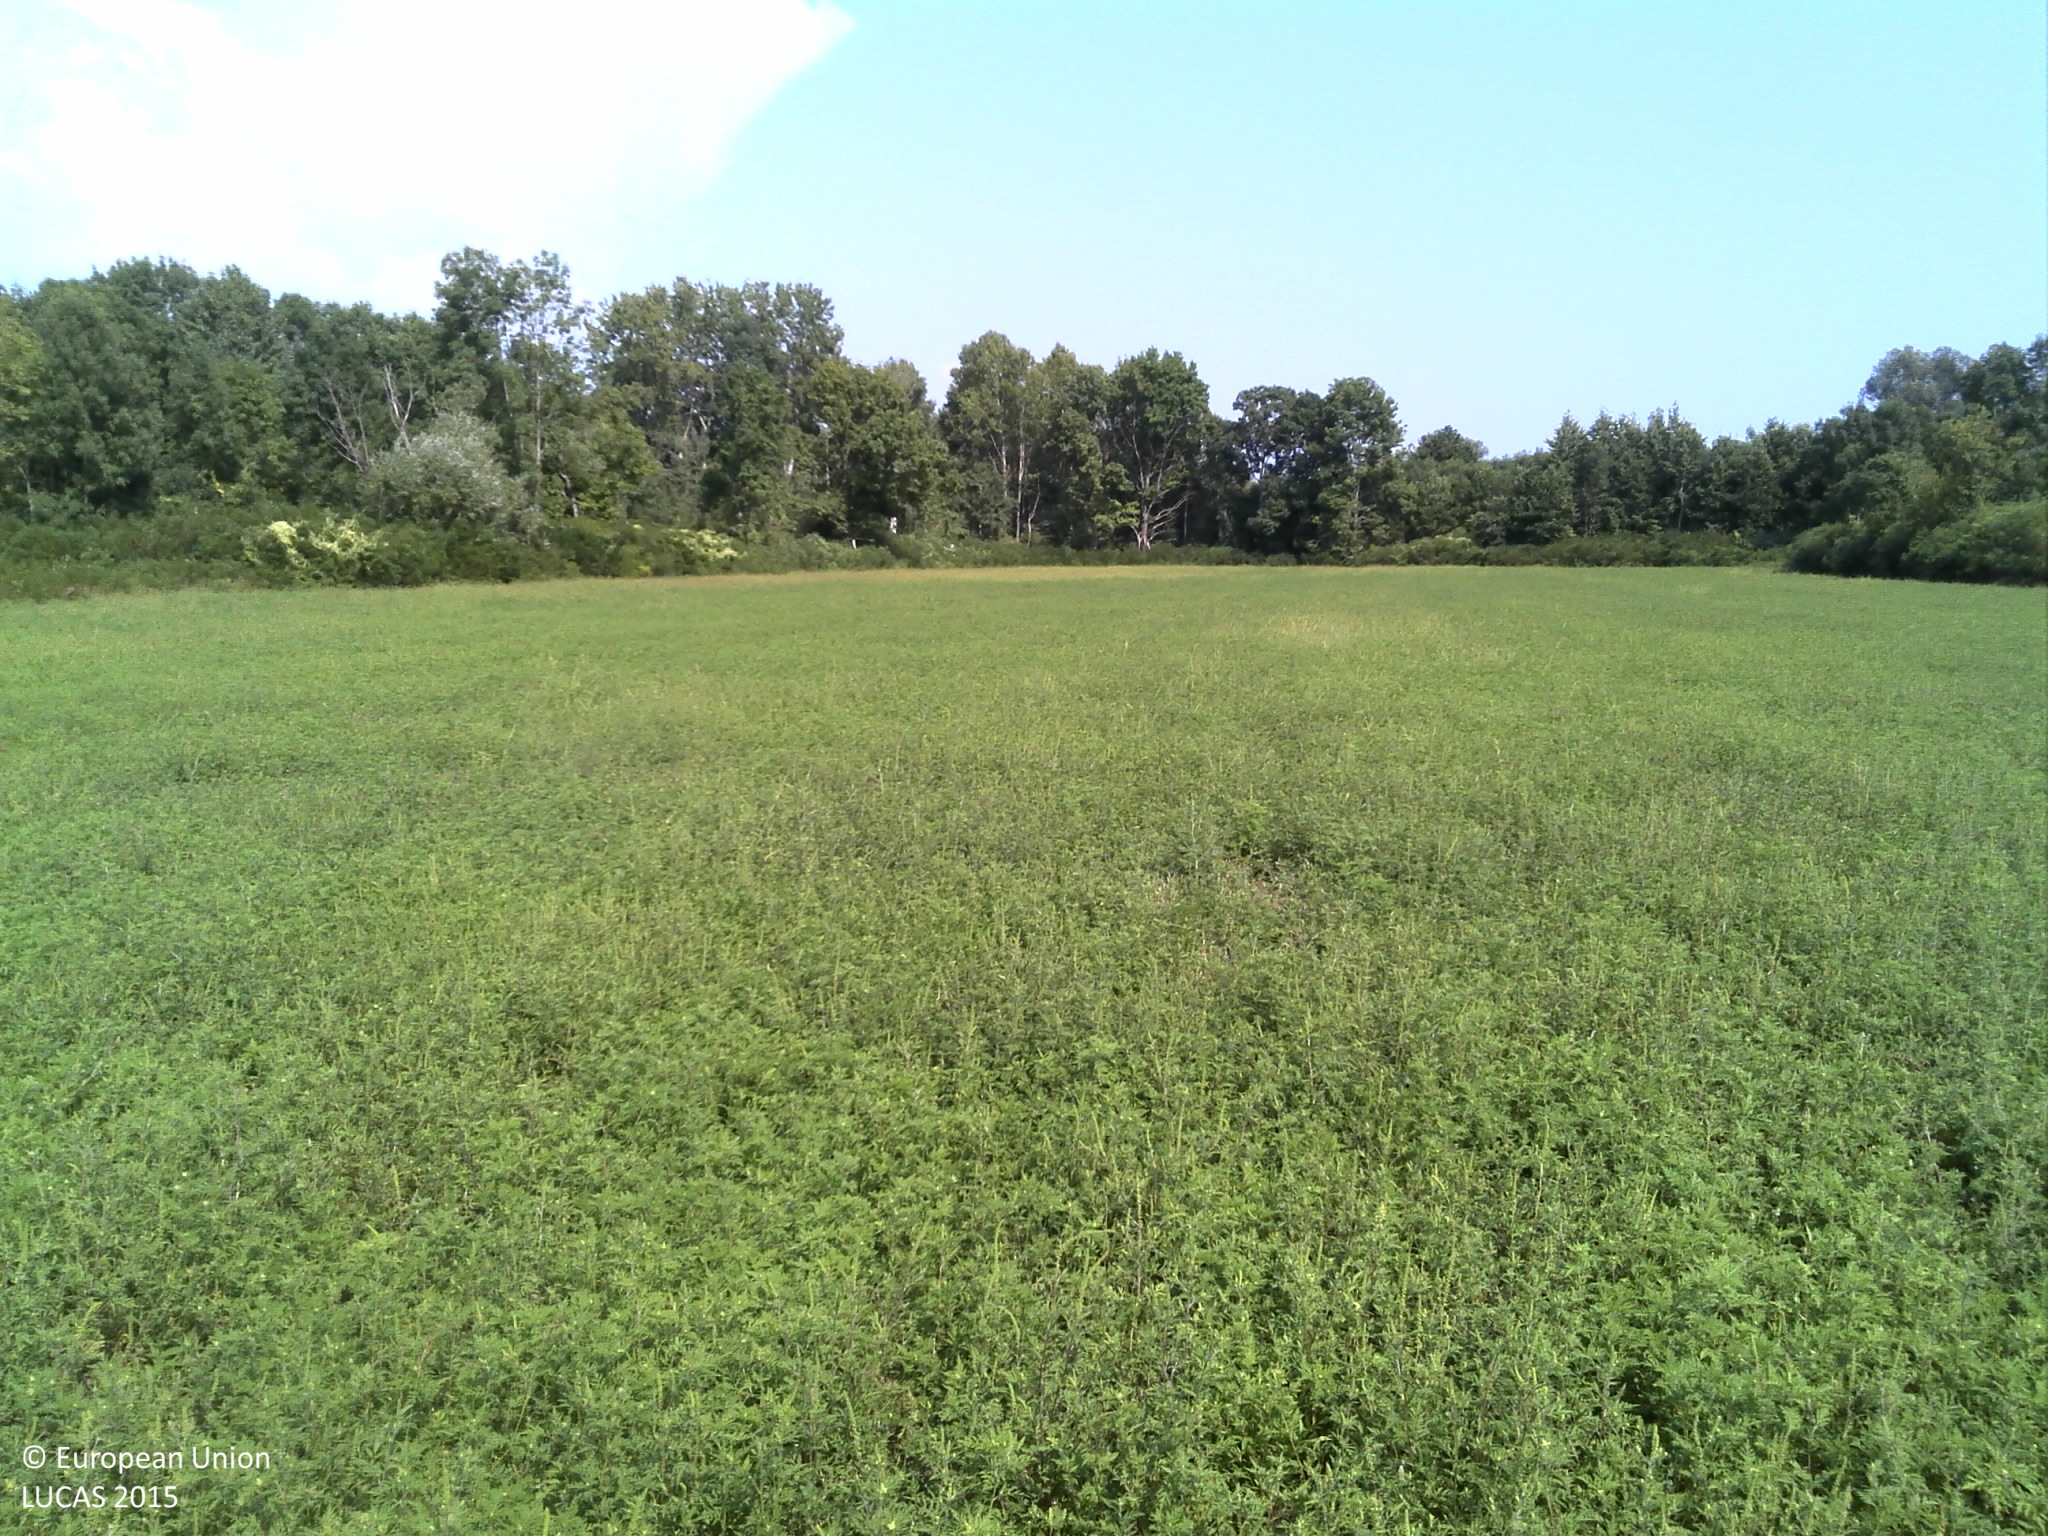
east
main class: Grassland
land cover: Spontaneously vegetated surfaces
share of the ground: > 75 %
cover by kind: herbaceous plants 100 %
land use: Fallow land
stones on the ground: < 10 %
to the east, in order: Spontaneously vegetated surfaces; Ditches and canals; Groves; Broadleaved woodland
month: August
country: HR
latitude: 45.2064
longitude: 17.1671
